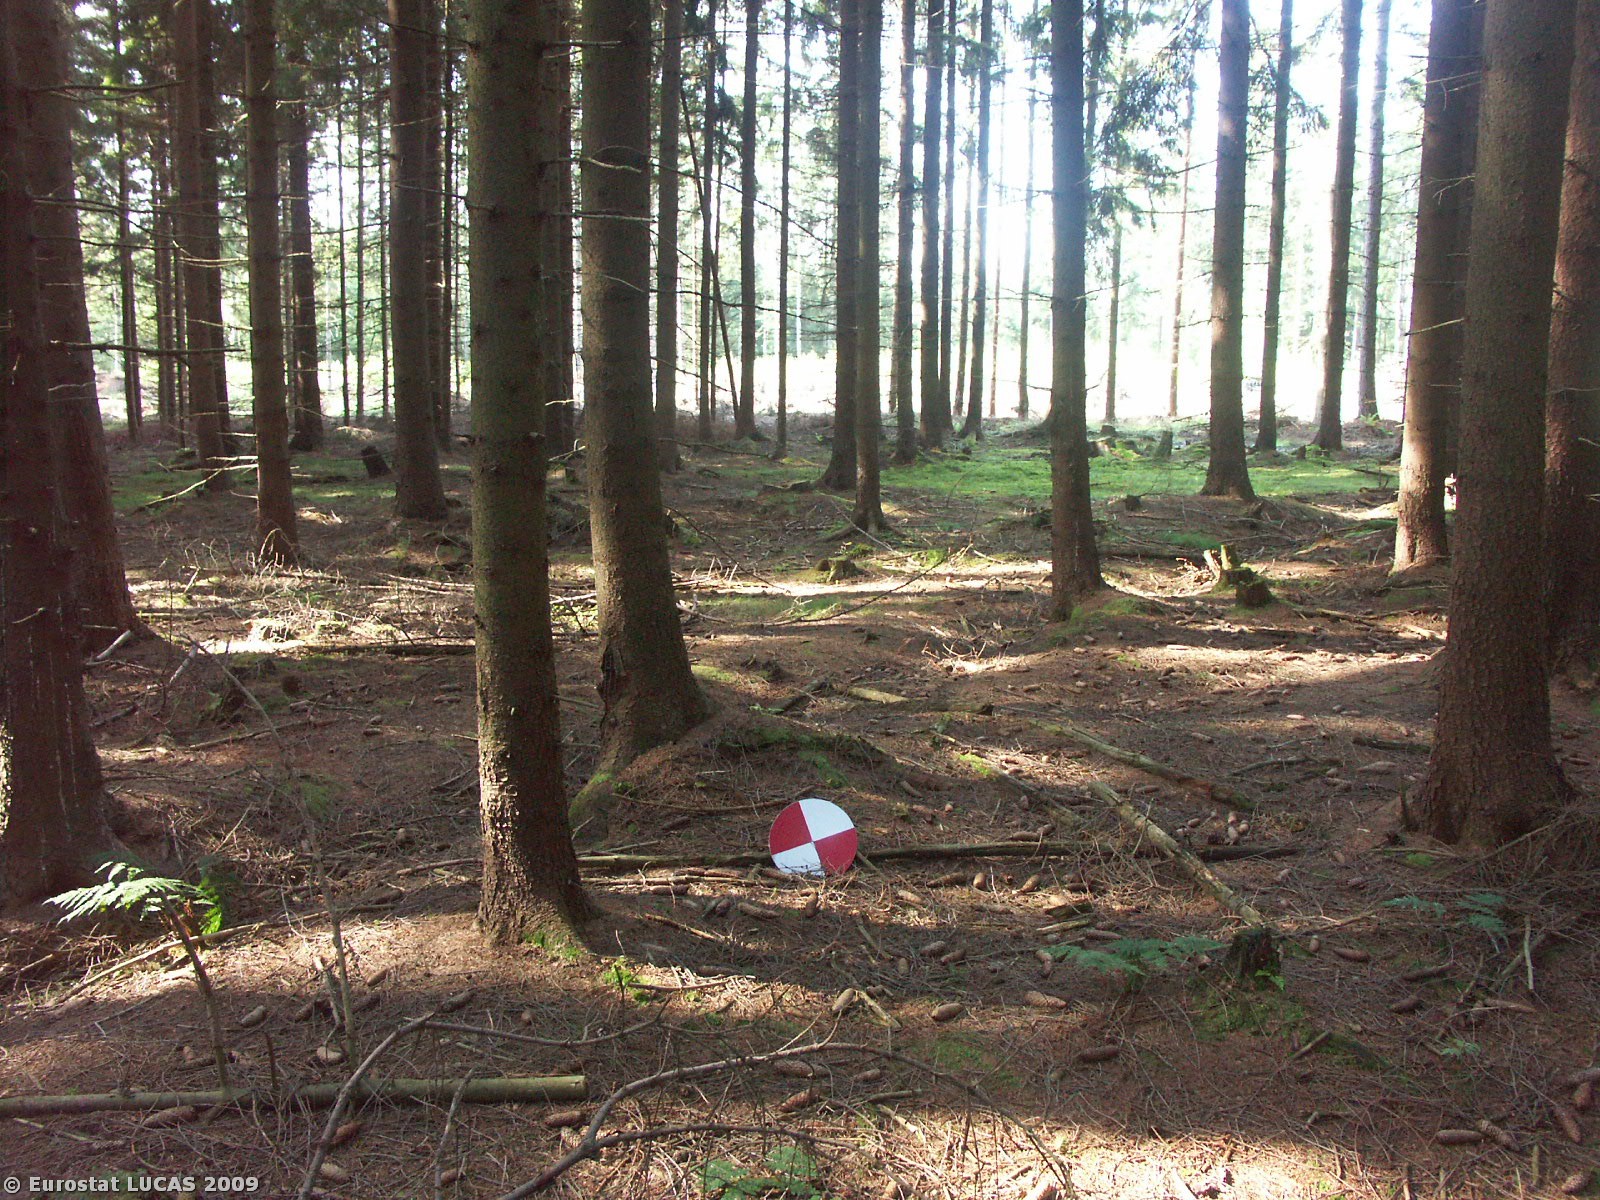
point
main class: Woodland
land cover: Coniferous woodland
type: hemiboreal forest and nemoral coniferous forest and mixed broadleaved-coniferous forest
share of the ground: > 75 %
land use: Forestry
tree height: > 5 m
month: July
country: CZ
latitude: 49.9787
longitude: 17.4167
